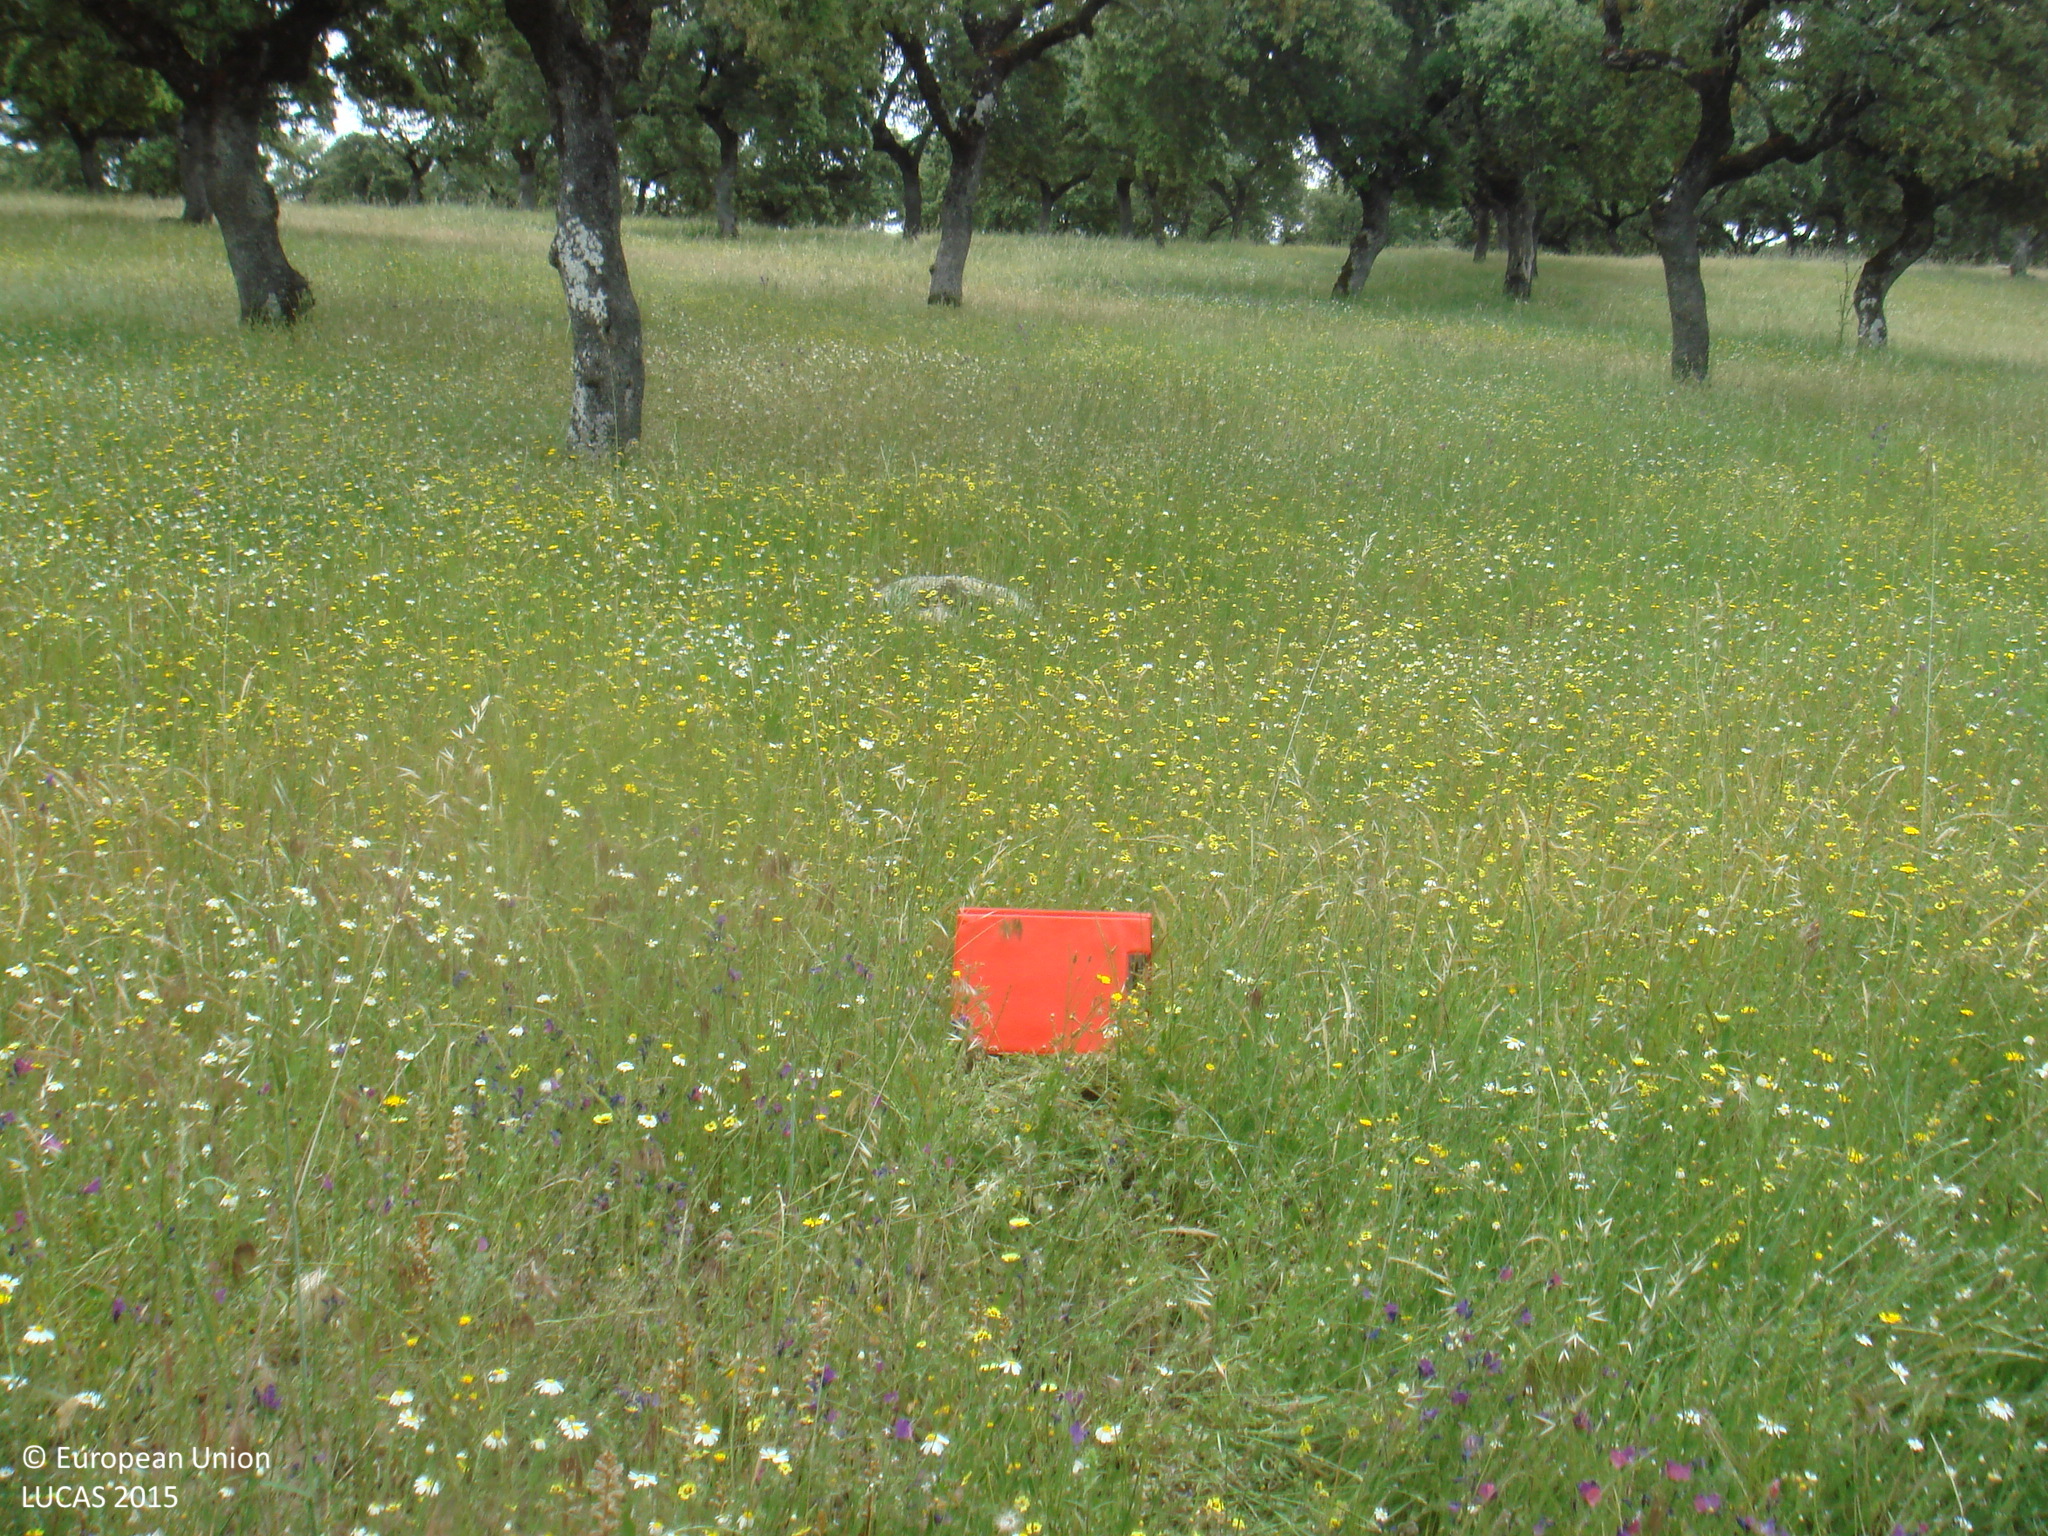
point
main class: Woodland
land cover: Broadleaved woodland
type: broadleaved evergreen forest
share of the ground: 50 - 75 %
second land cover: Grassland without tree/shrub cover
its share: > 75 %
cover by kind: broadleaved forest trees 50 %, herbaceous plants 50 %
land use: Forestry
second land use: Agriculture (excluding fallow land and kitchen gardens)
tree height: > 5 m
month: May
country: ES
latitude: 38.2831
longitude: -4.3858
